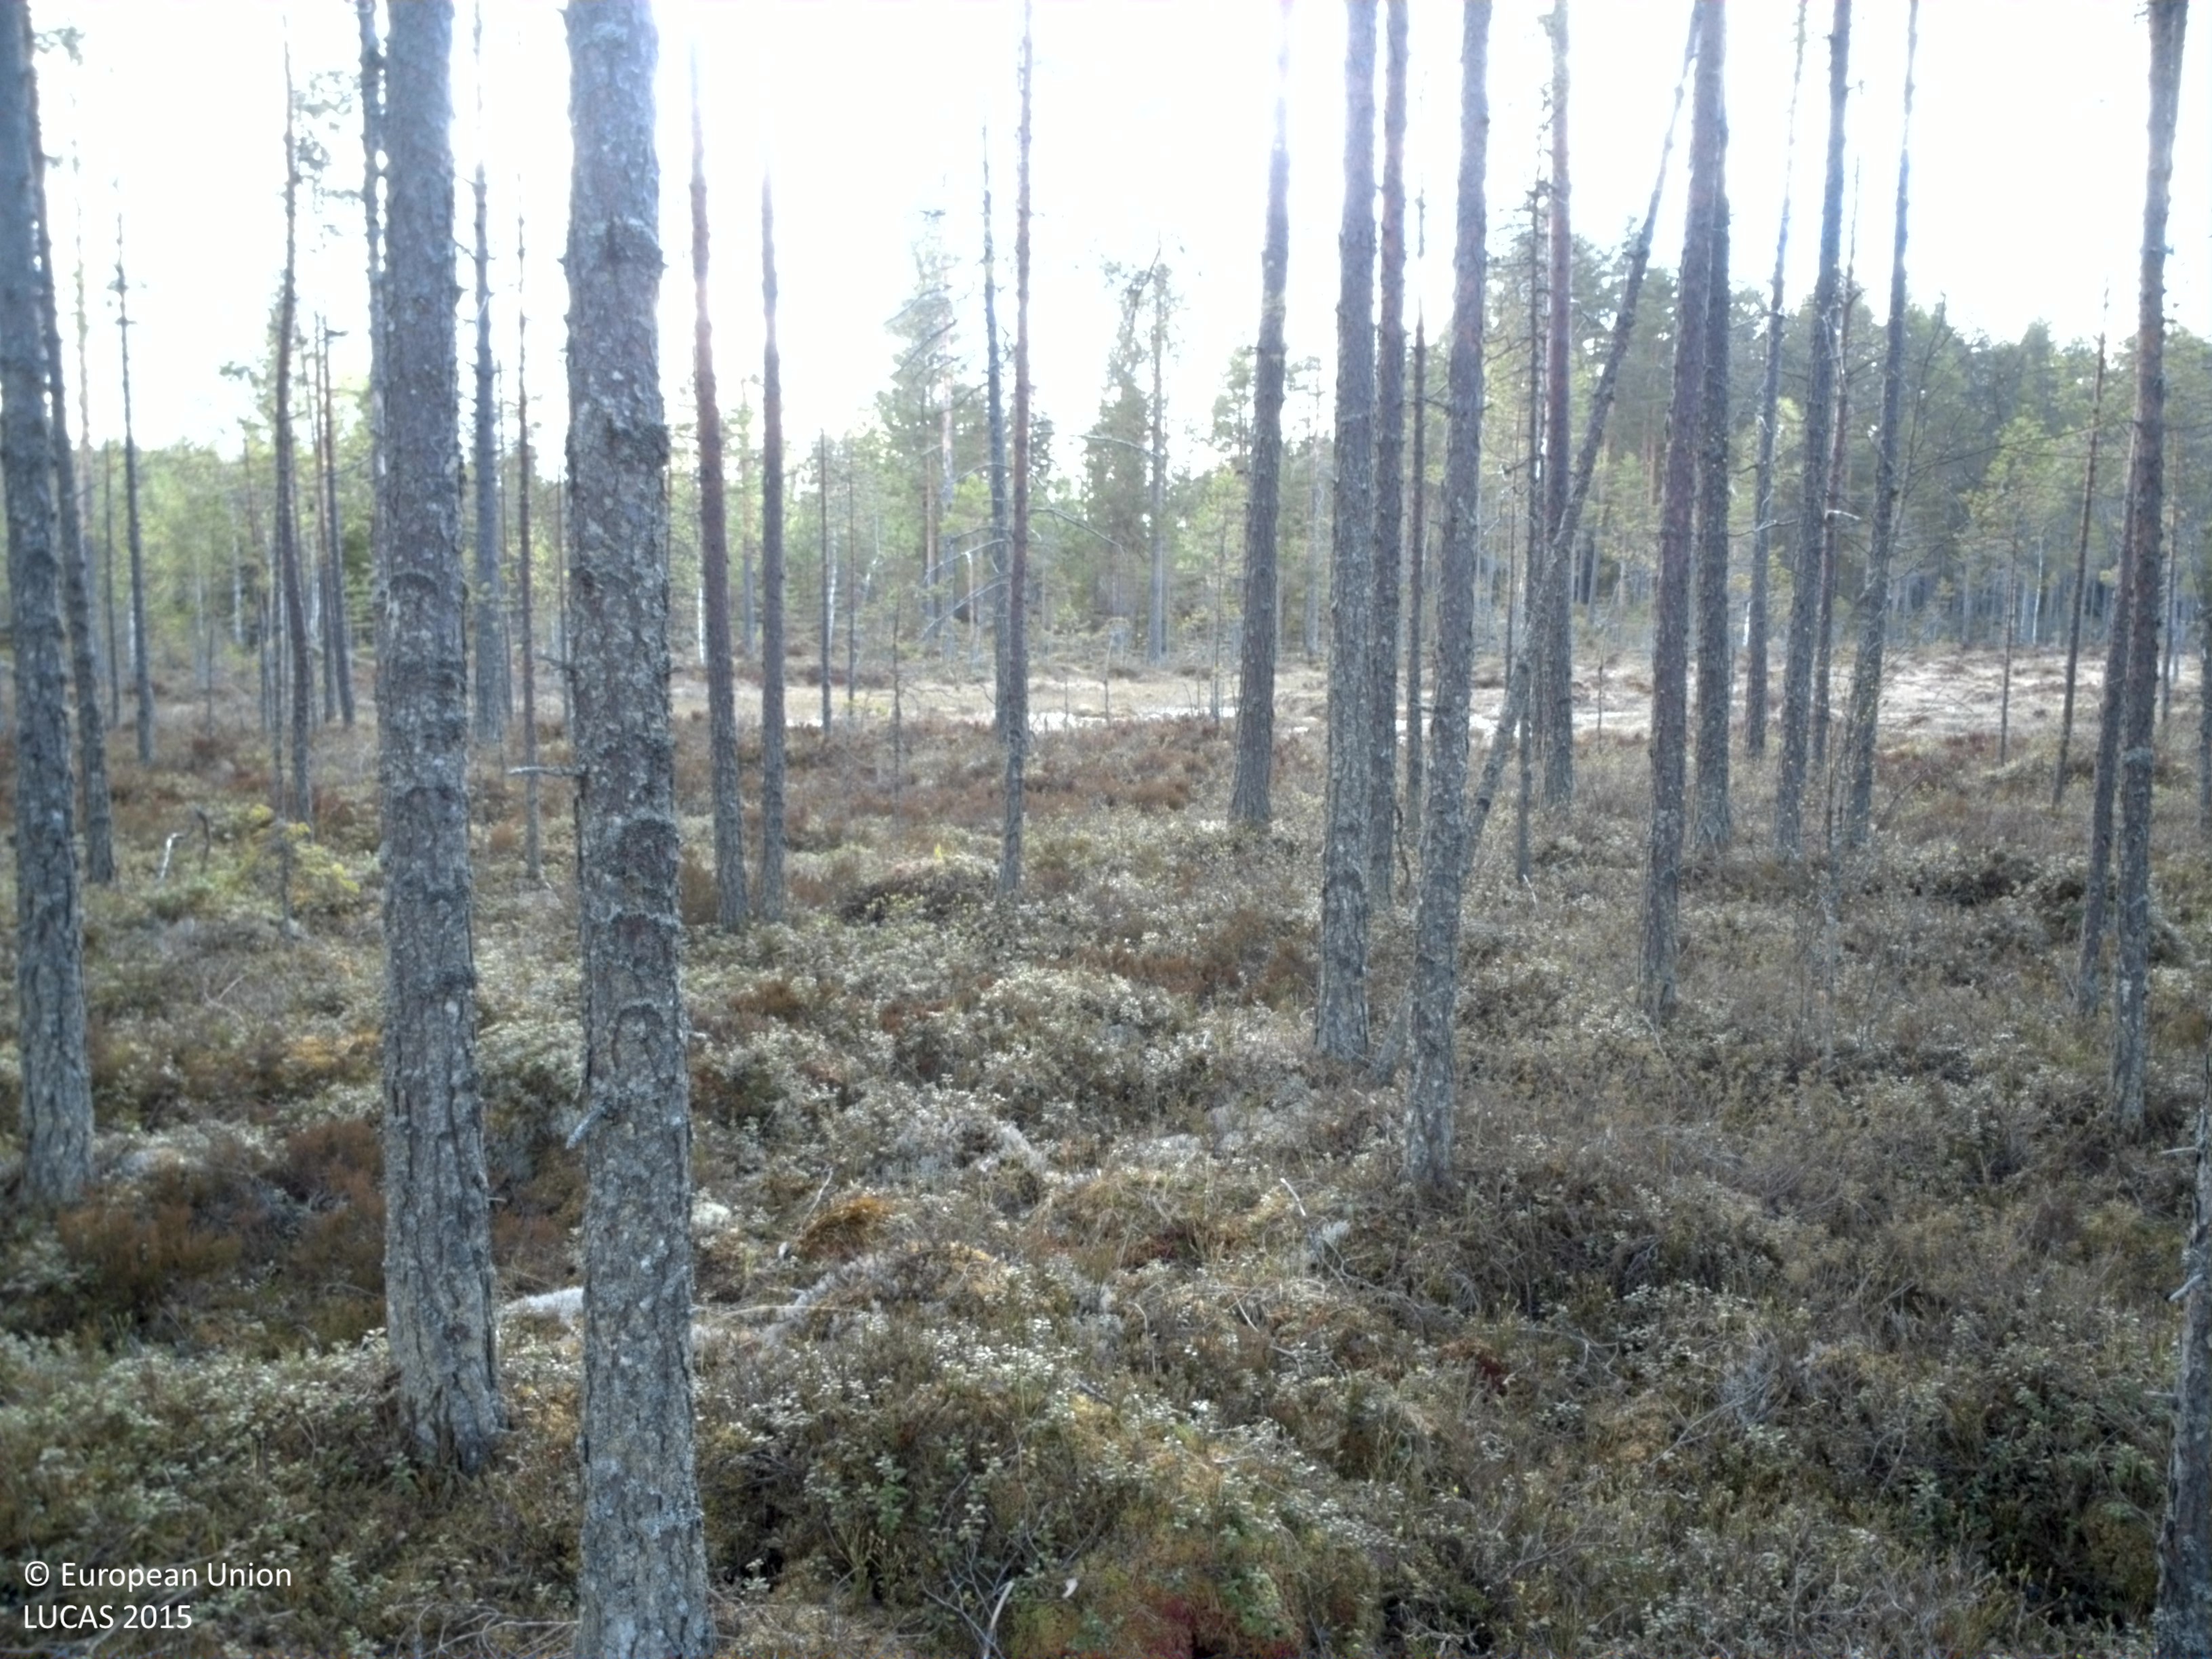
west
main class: Woodland
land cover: Pine dominated coniferous woodland
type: boreal forest
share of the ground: > 75 %
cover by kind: coniferous forest trees 80 %, shrubs 20 %
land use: Forestry
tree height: > 5 m
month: May
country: SE
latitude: 61.1535
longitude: 15.0952
